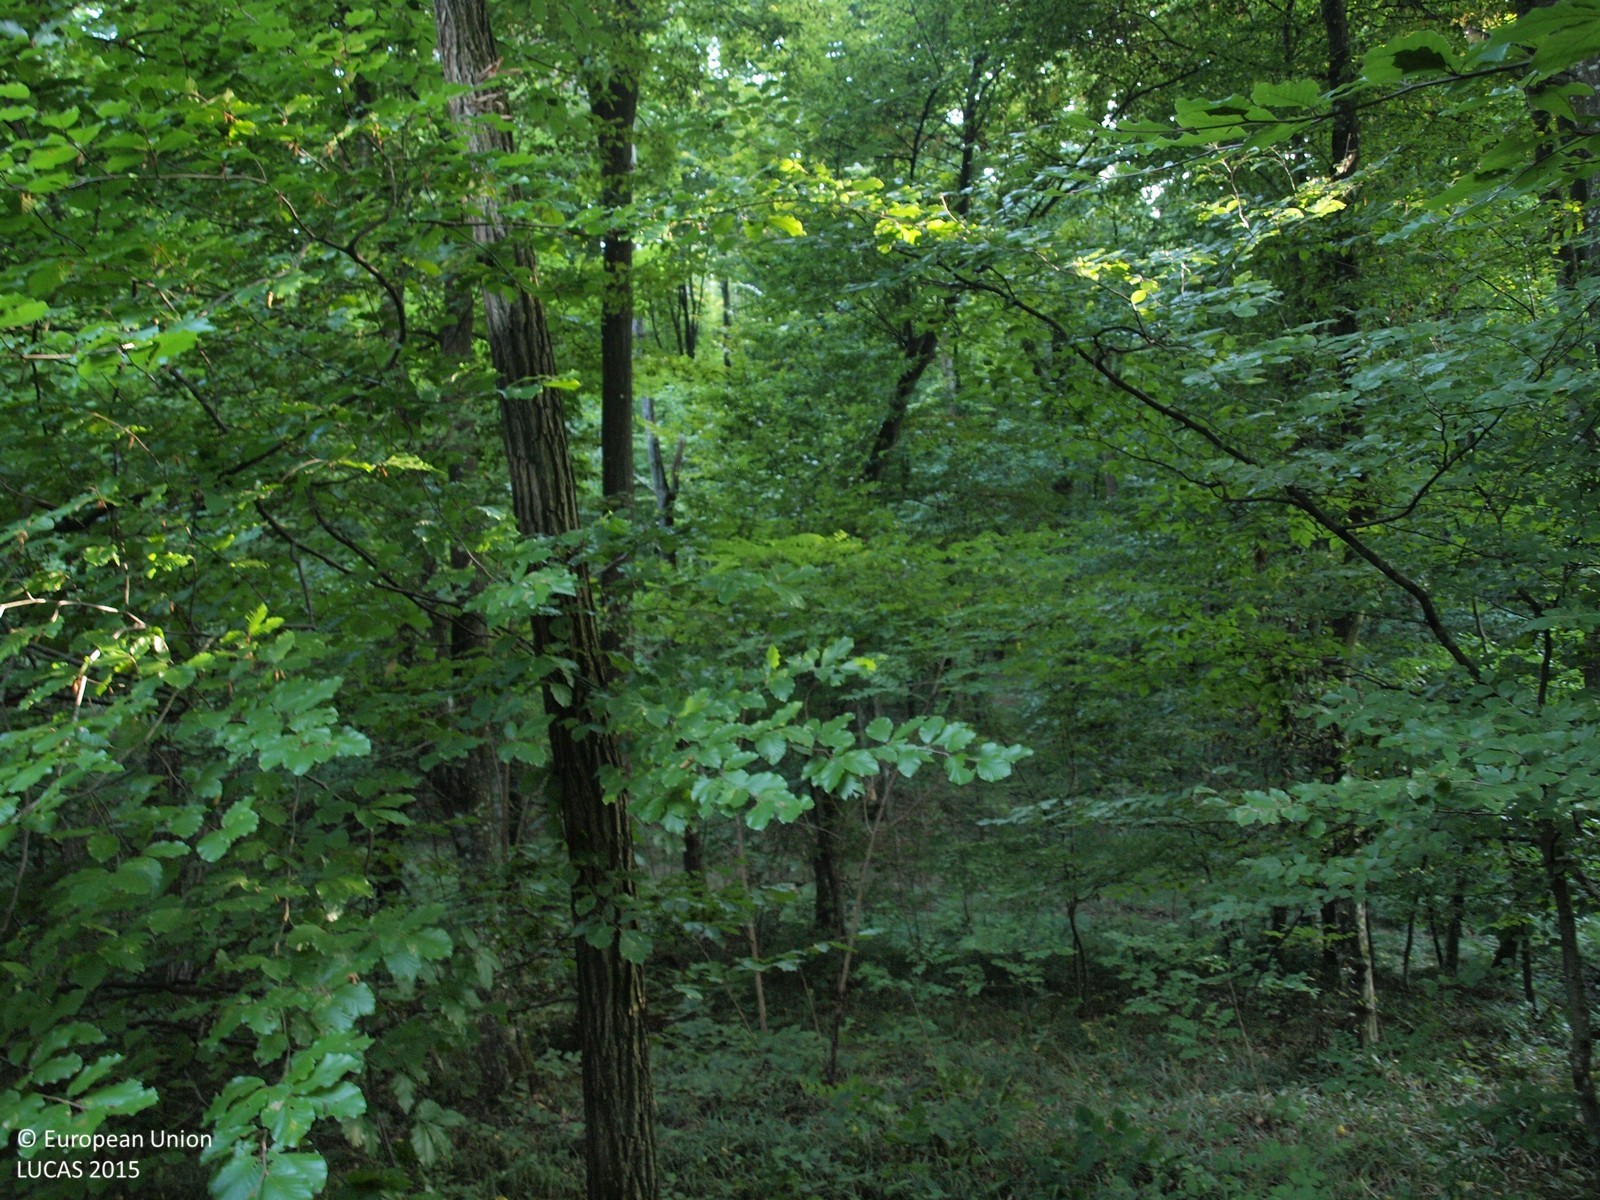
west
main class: Woodland
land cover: Broadleaved woodland
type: beech forest
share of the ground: > 75 %
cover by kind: broadleaved forest trees 100 %
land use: Forestry
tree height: > 5 m
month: August
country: HR
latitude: 46.0582
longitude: 16.5795
